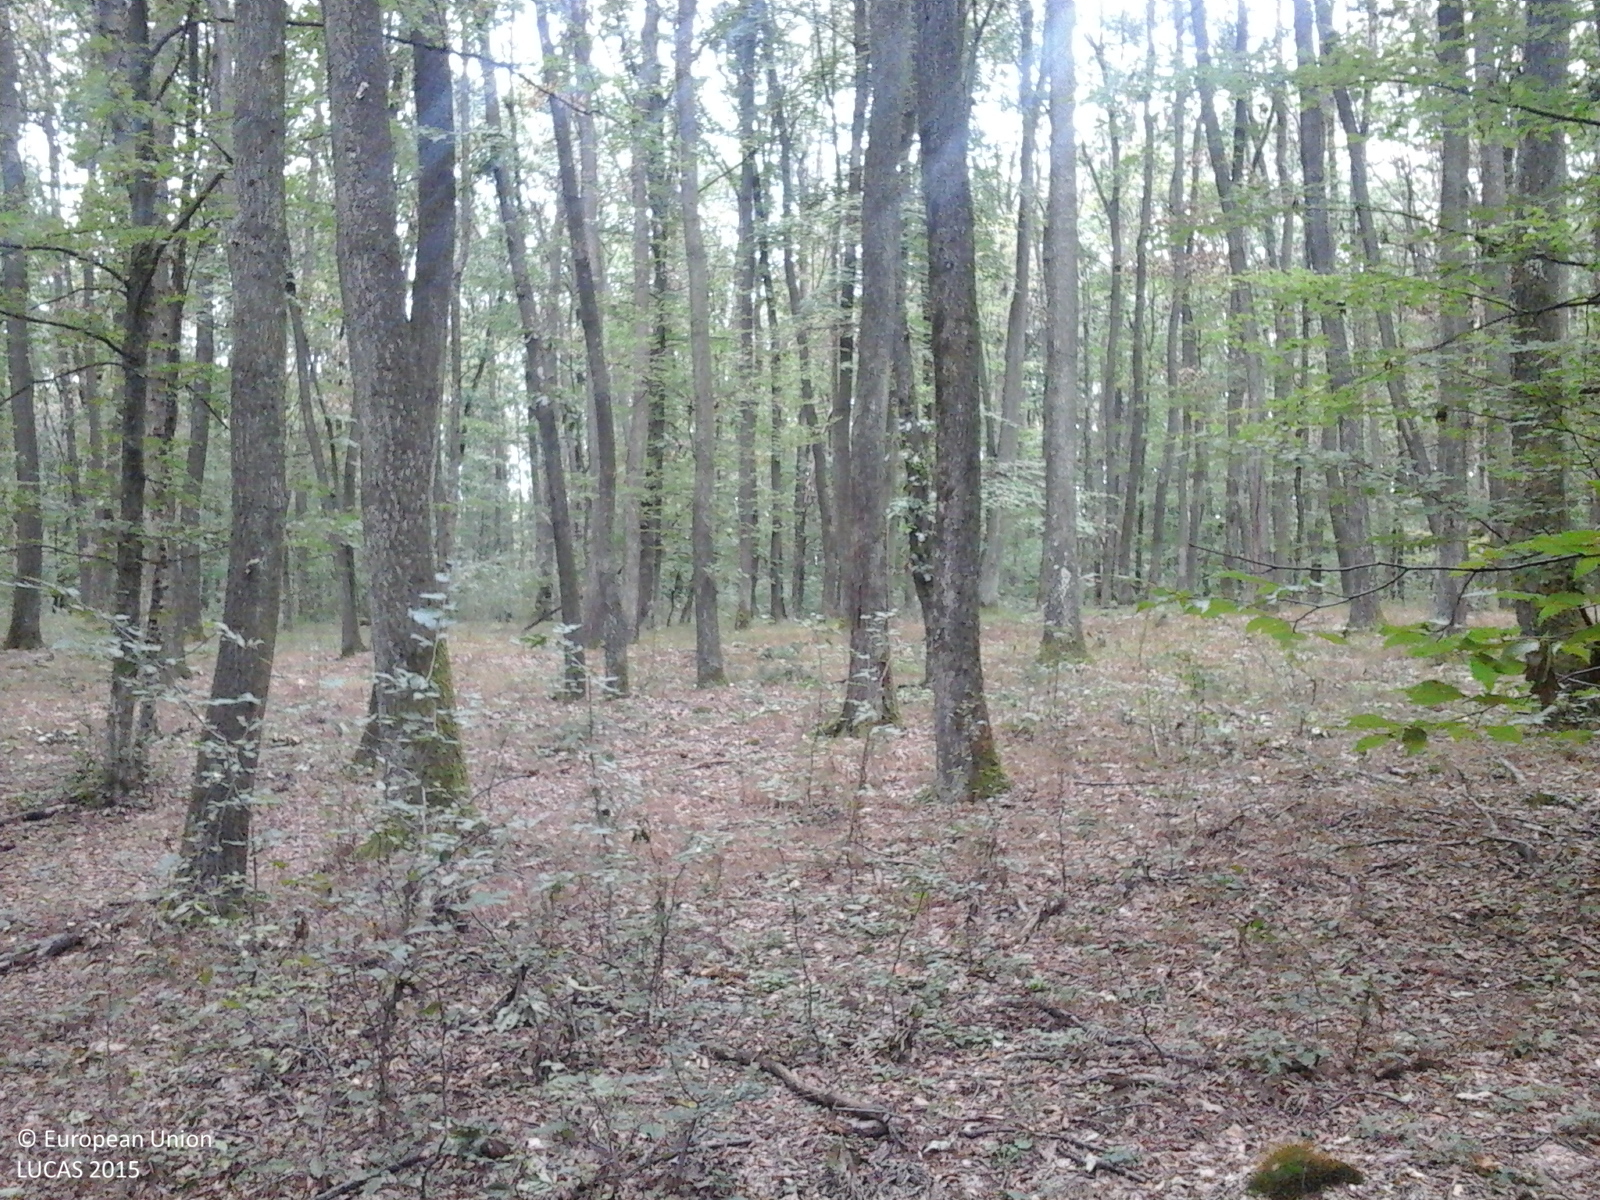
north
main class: Woodland
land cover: Broadleaved woodland
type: acidophilous oak and oak-birch forest
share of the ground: > 75 %
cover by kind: broadleaved forest trees 100 %
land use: Forestry
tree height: > 5 m
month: September
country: RO
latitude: 47.3991
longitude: 22.6596
